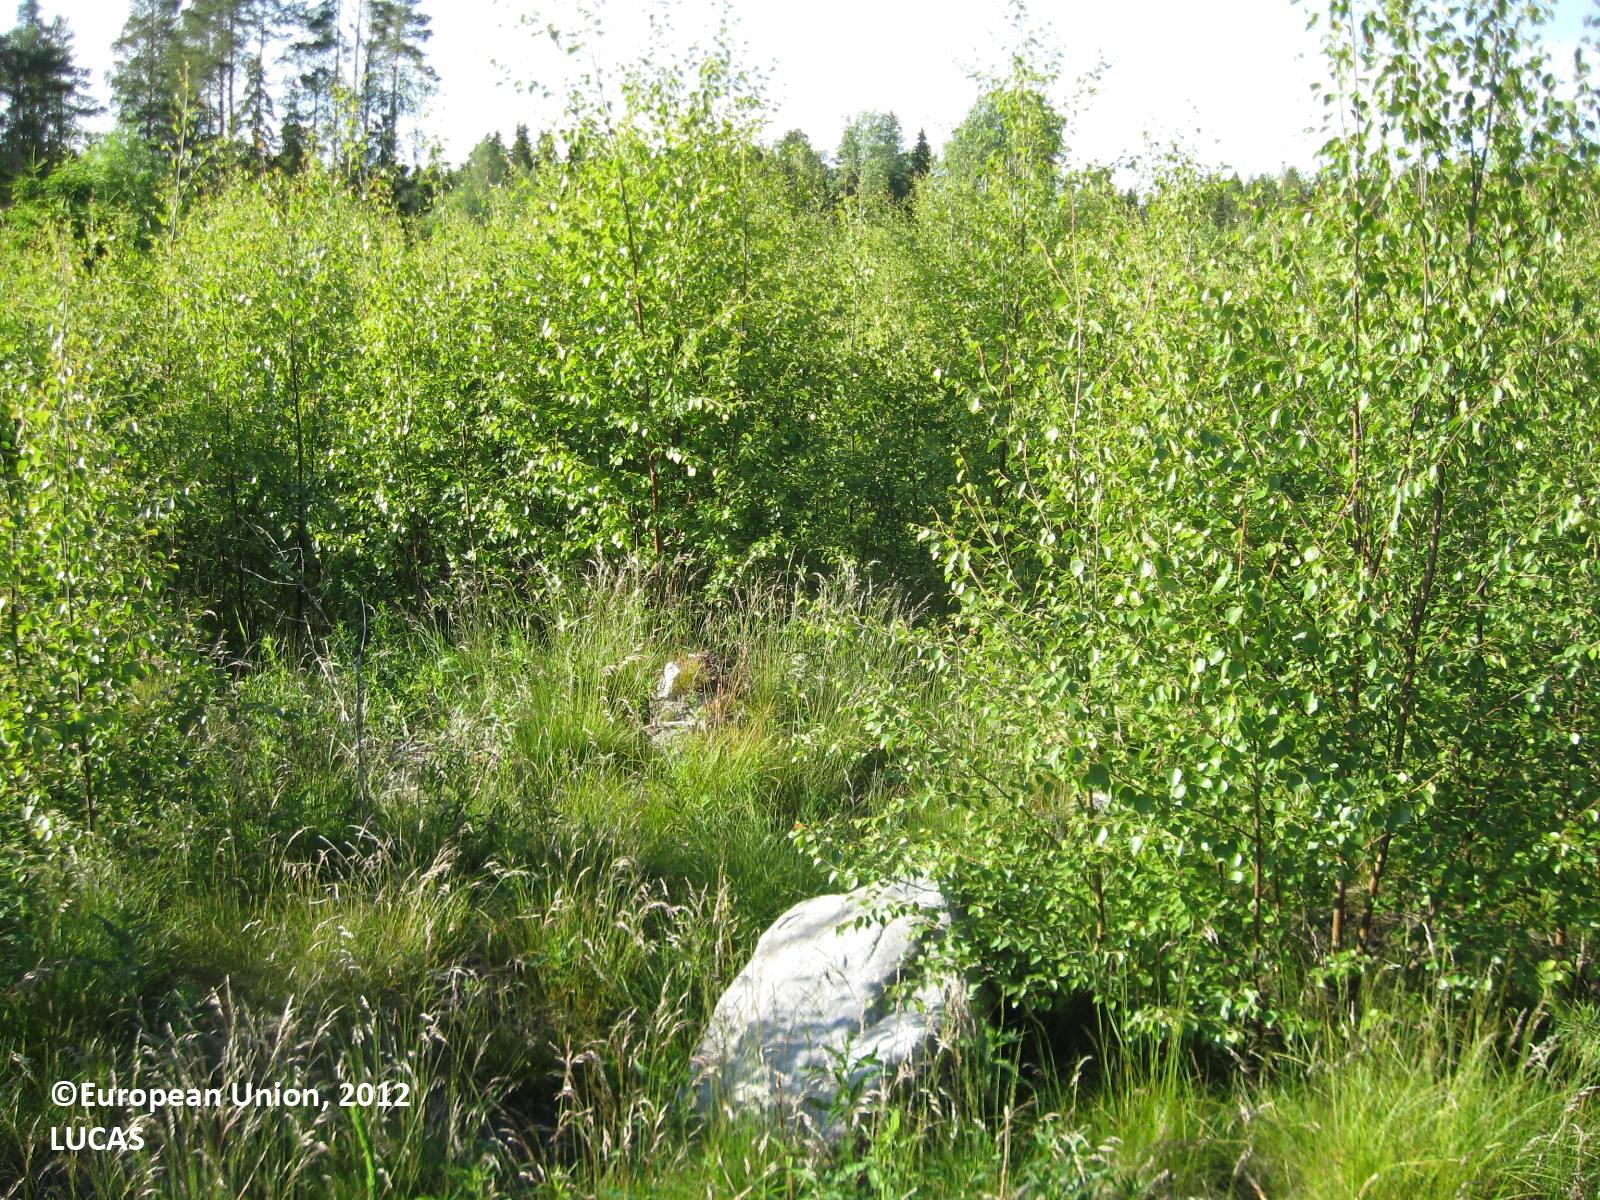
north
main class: Woodland
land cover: Broadleaved woodland
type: boreal forest
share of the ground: > 75 %
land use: Forestry
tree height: < 5 m
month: June
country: FI
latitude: 62.6189
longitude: 21.6012
